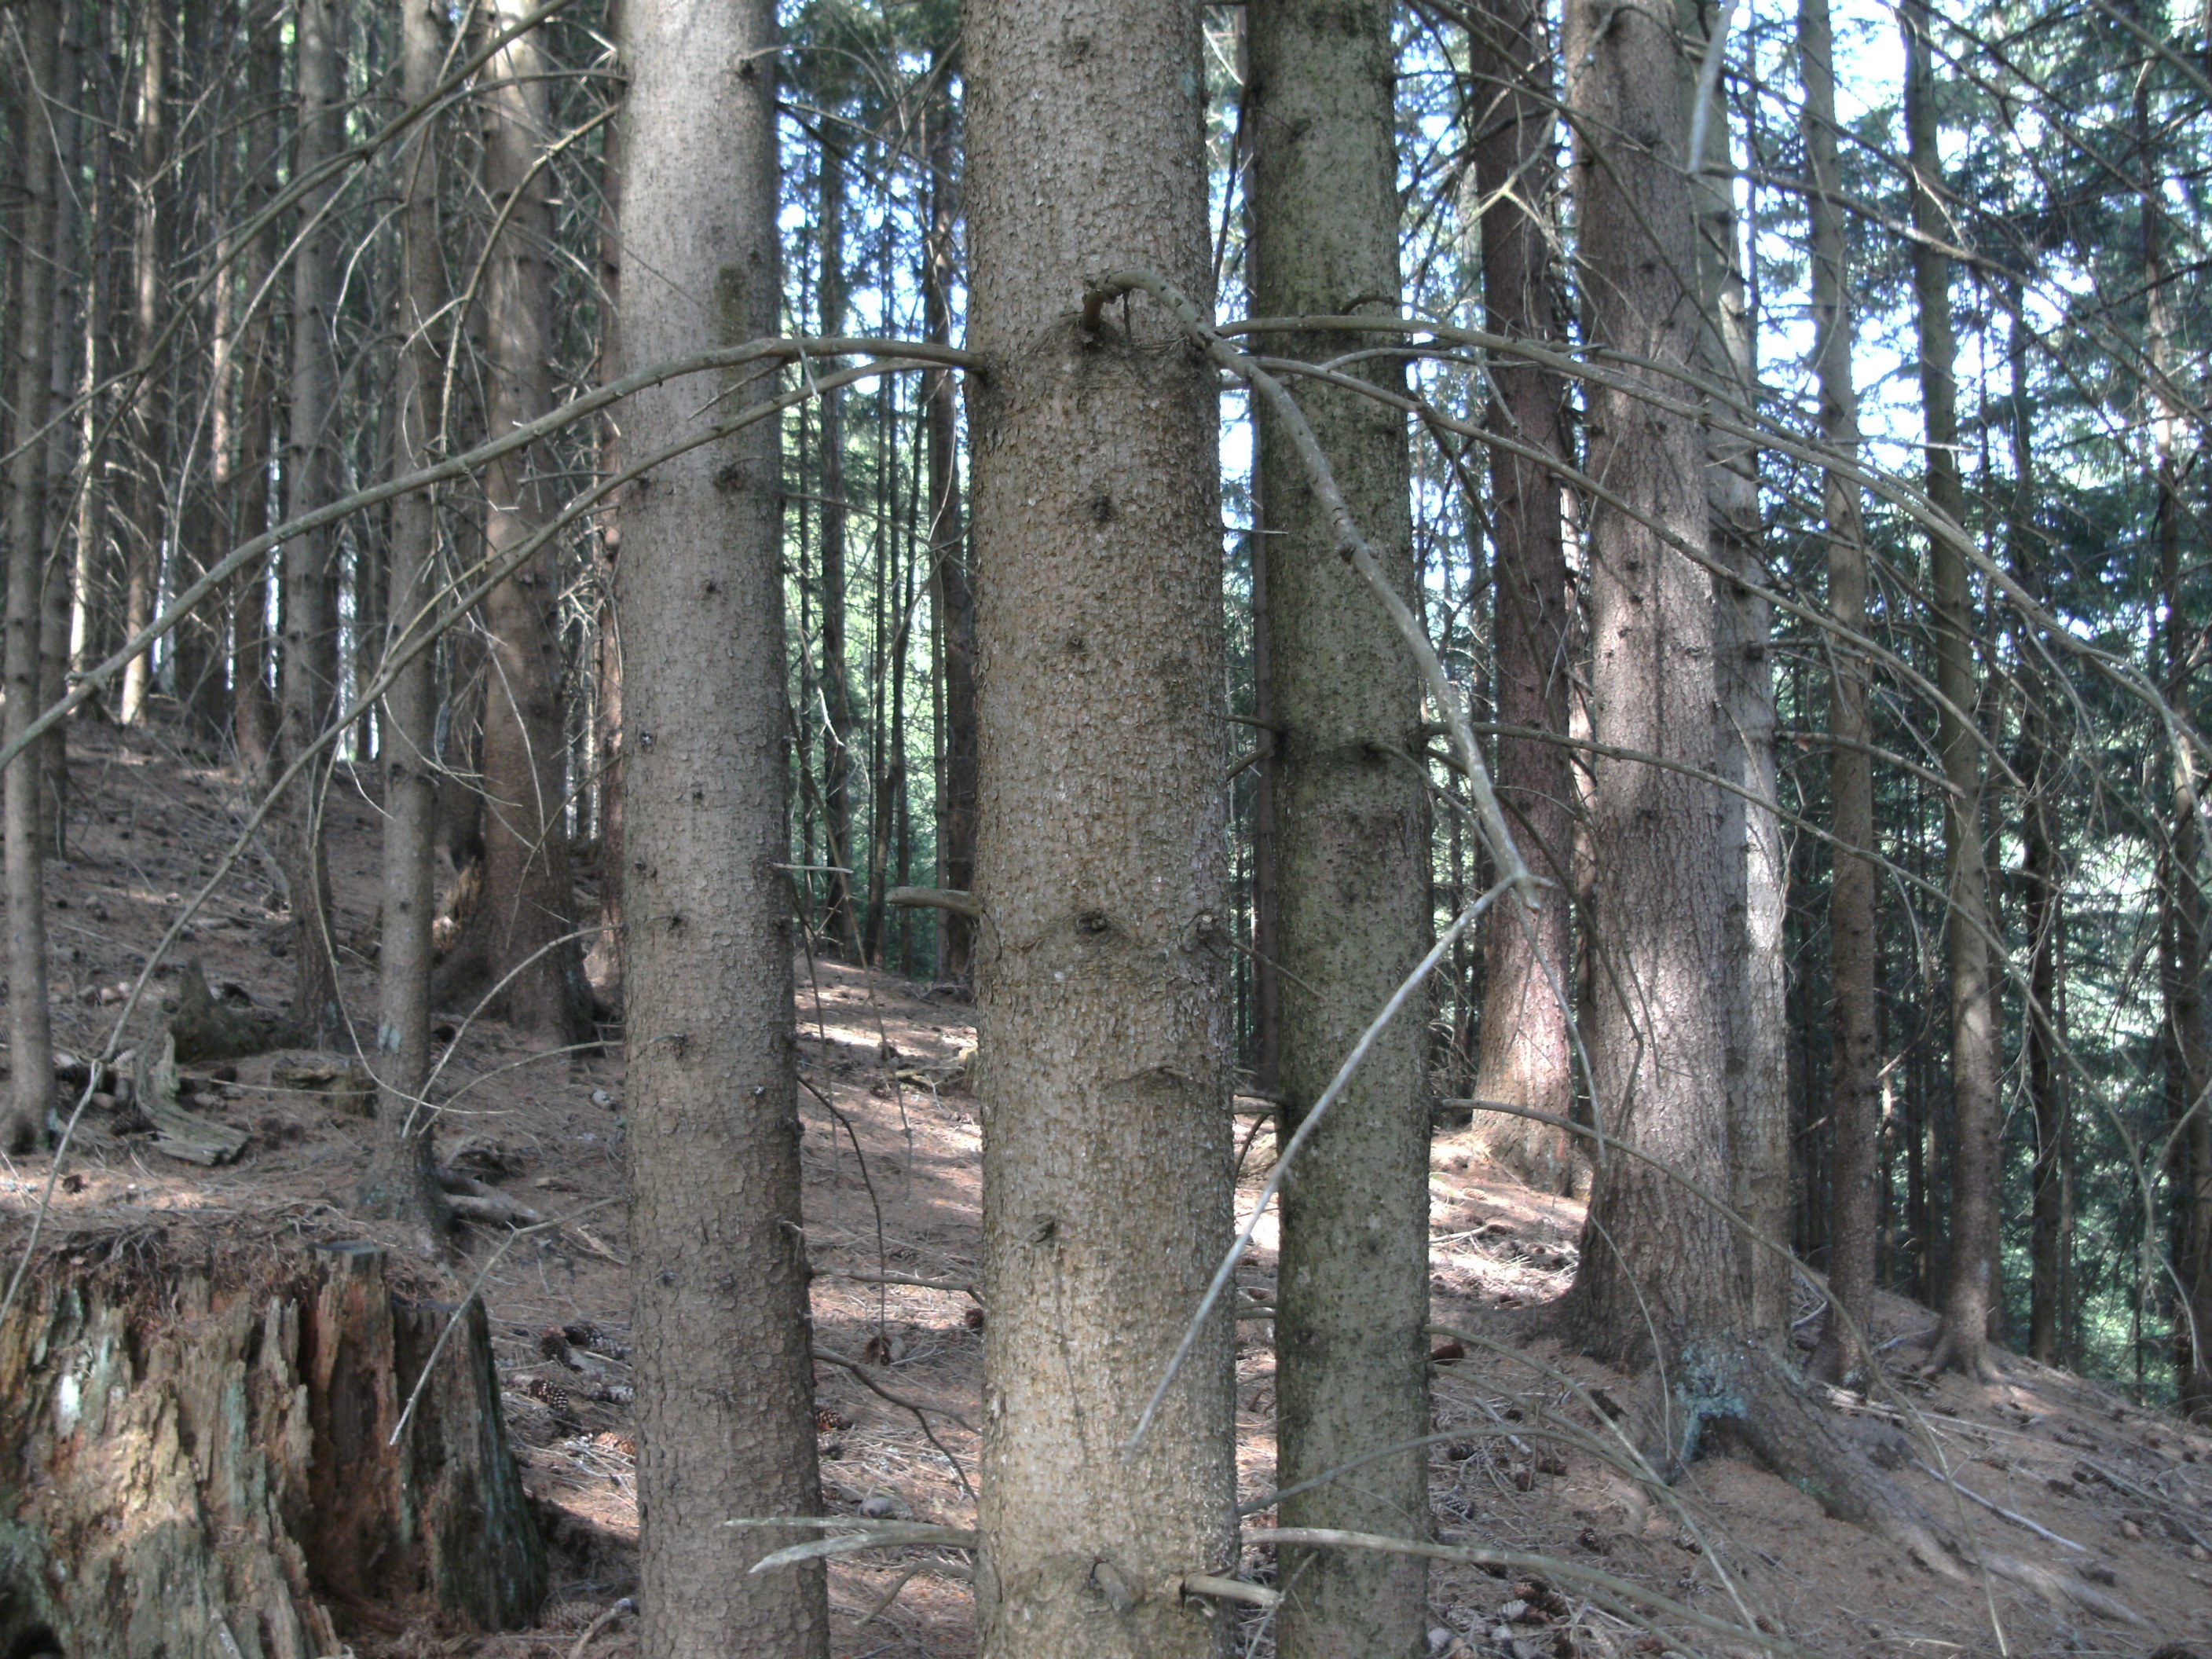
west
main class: Woodland
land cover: Spruce dominated coniferous woodland
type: hemiboreal forest and nemoral coniferous forest and mixed broadleaved-coniferous forest
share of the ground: > 75 %
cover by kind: coniferous forest trees 90 %, unconsolidated bare surface 10 %
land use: Forestry
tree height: > 5 m
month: July
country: AT
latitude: 47.0046
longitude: 14.7202
